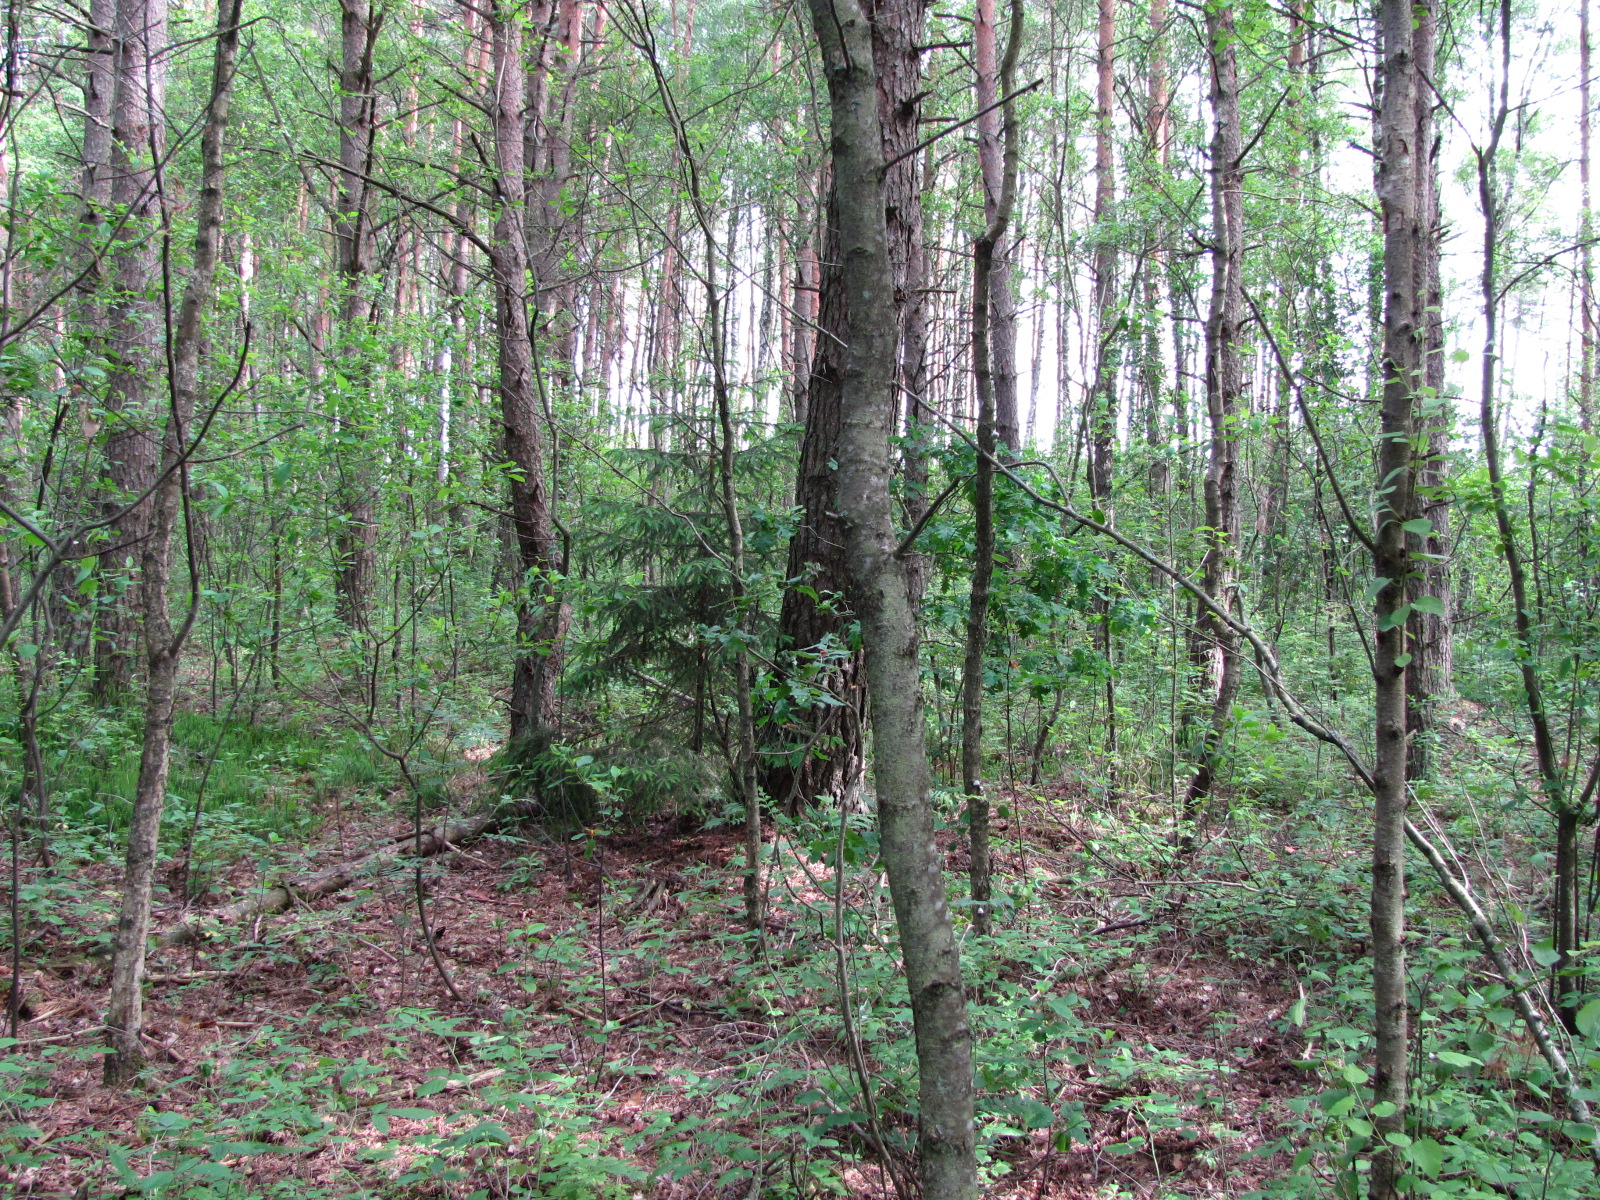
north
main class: Woodland
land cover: Pine dominated mixed woodland
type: mire and swamp forests
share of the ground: > 75 %
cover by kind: coniferous forest trees 70 %, broadleaved forest trees 30 %
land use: Forestry
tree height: > 5 m
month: June
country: LV
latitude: 56.8726
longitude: 23.8789
